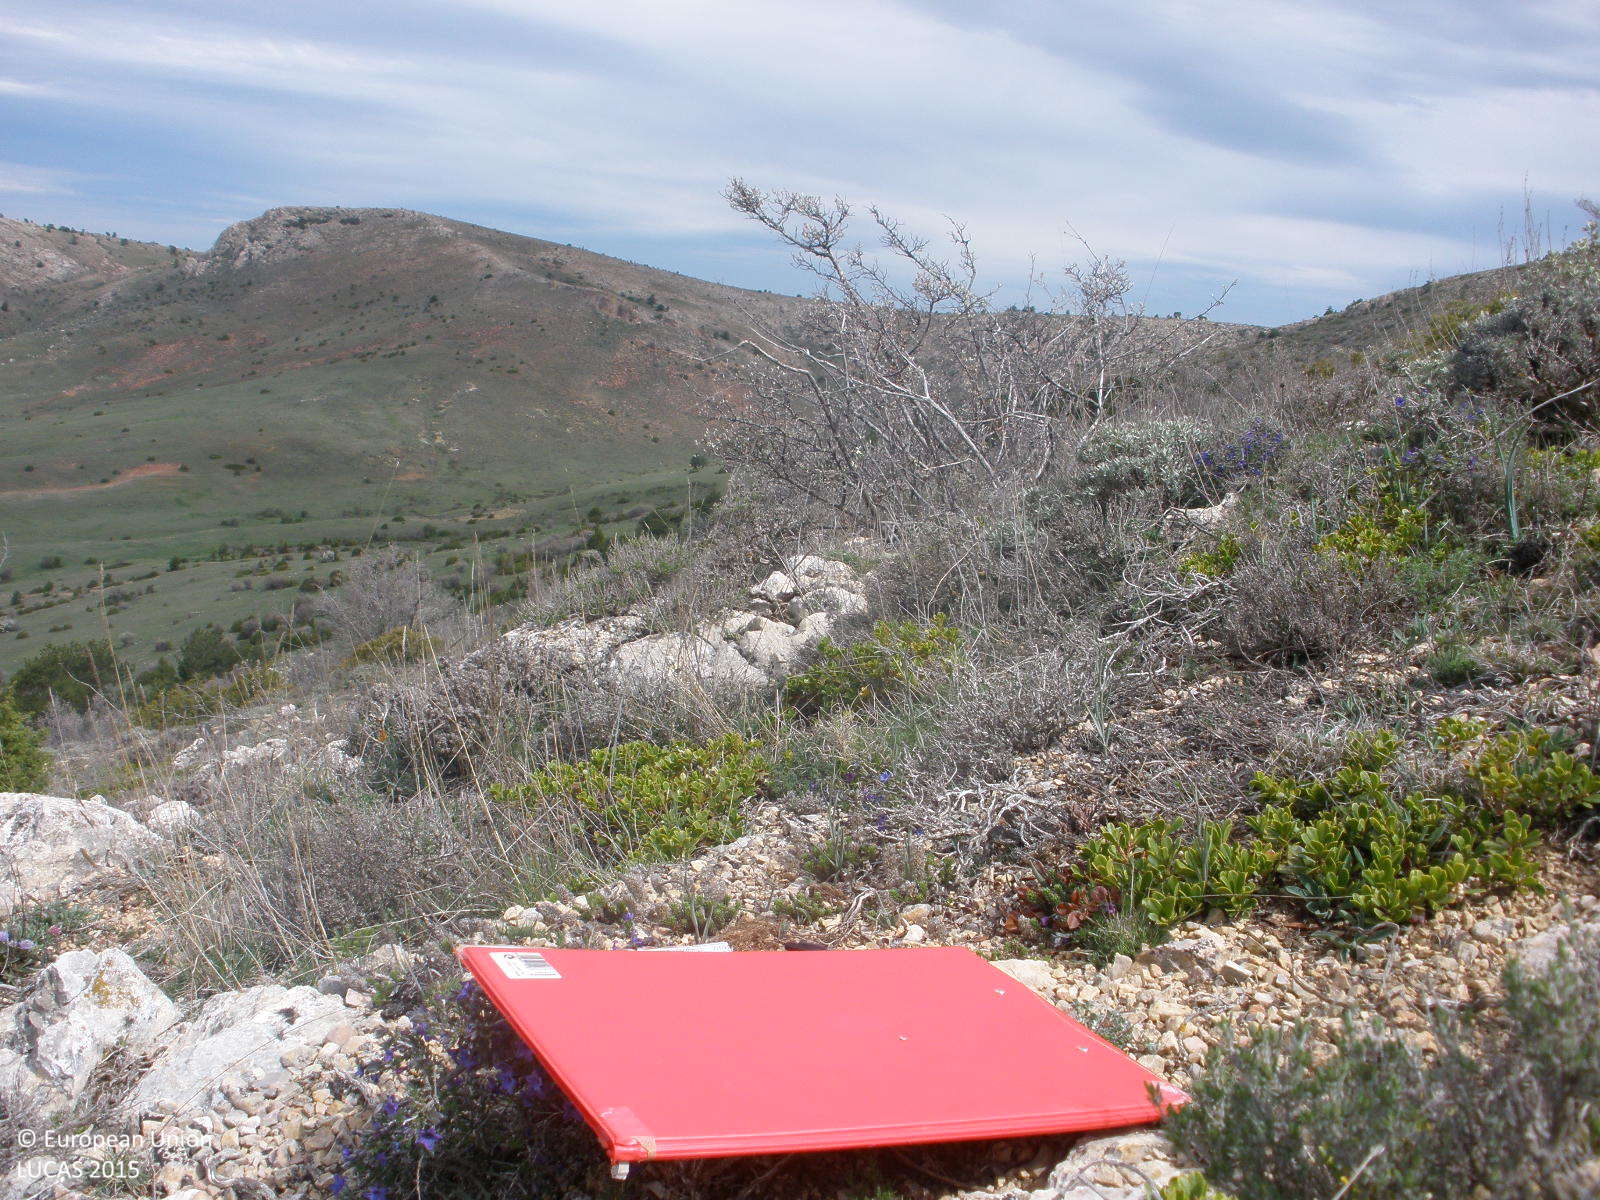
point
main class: Shrubland
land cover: Shrubland without tree cover
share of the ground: > 75 %
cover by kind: shrubs 75 %, herbaceous plants 15 %, consolidated bare surface 10 %
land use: Agriculture (excluding fallow land and kitchen gardens)
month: May
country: ES
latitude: 40.4562
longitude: -0.7758
